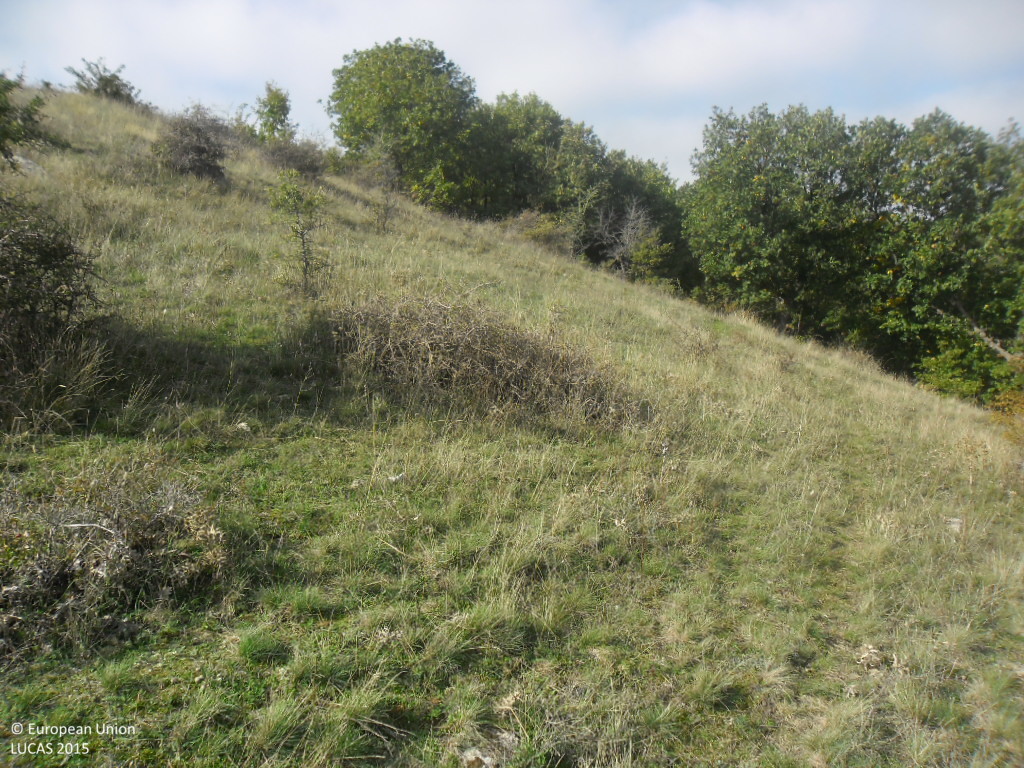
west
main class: Grassland
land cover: Grassland without tree/shrub cover
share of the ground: > 75 %
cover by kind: herbaceous plants 100 %
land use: Agriculture (excluding fallow land and kitchen gardens)
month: October
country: BG
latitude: 41.9323
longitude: 23.0598
